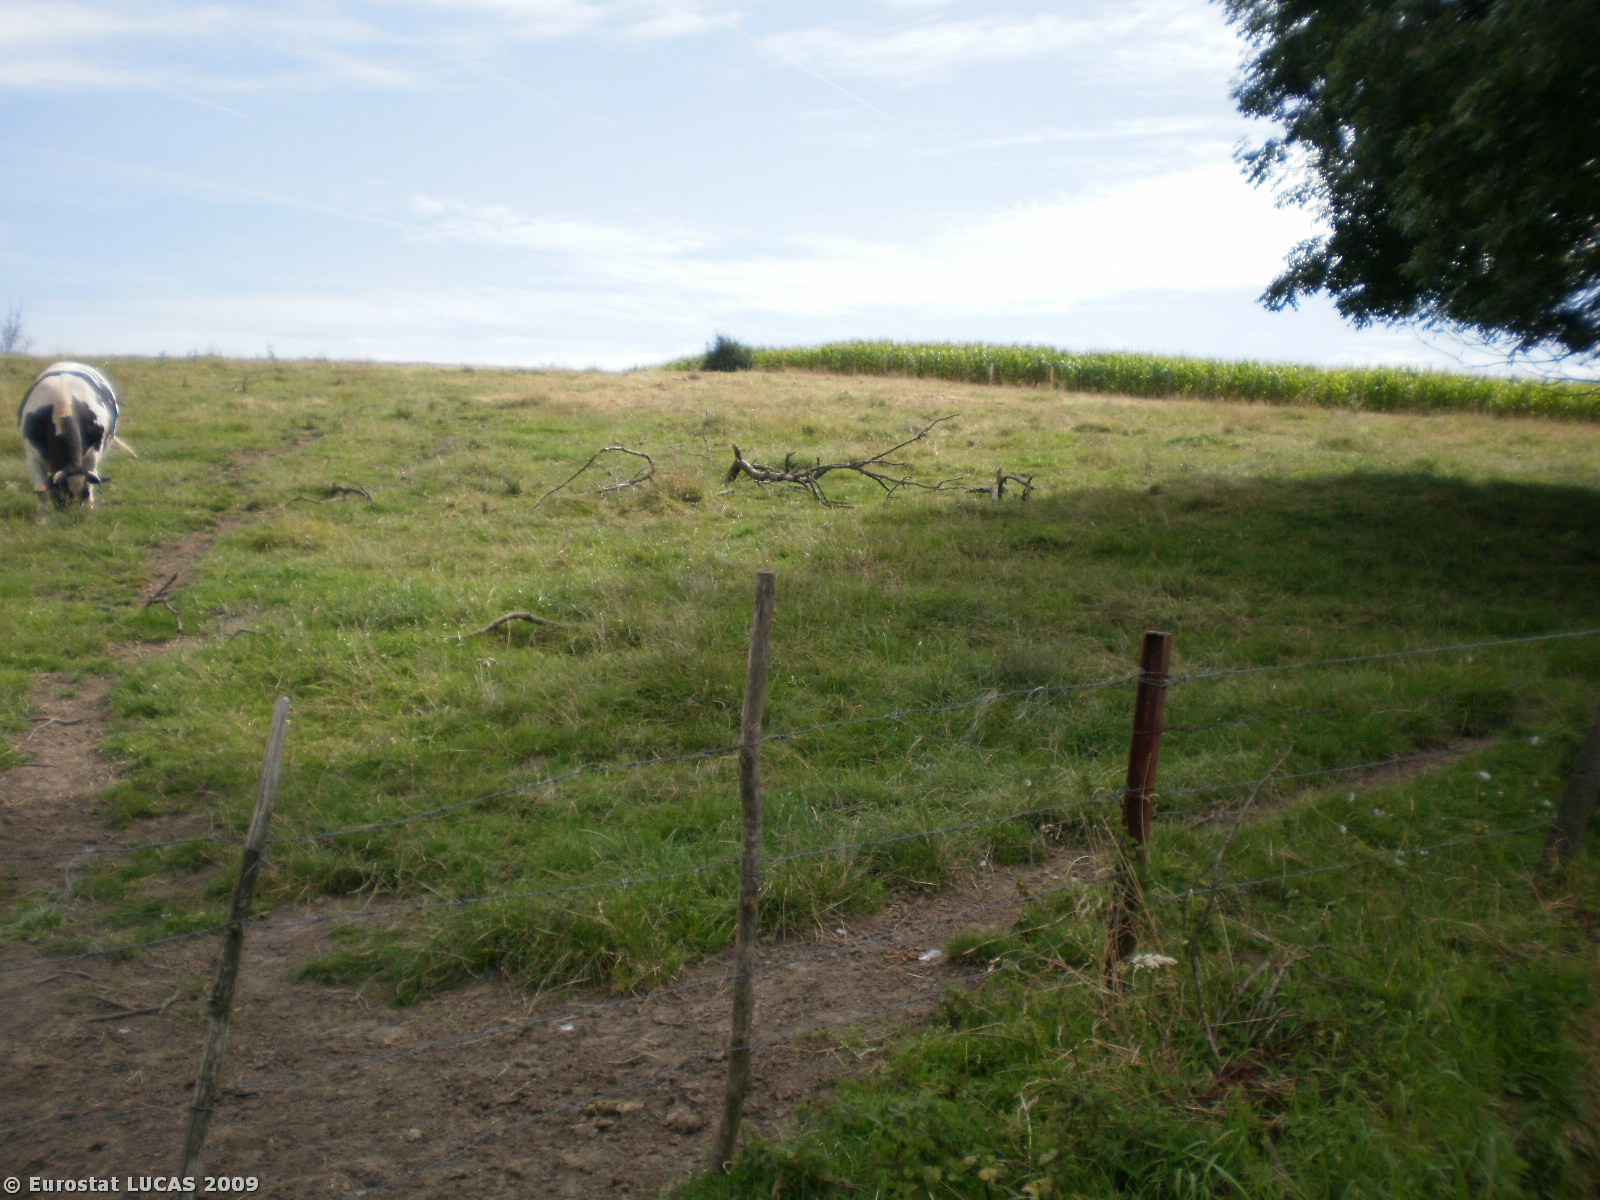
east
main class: Grassland
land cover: Grassland without tree/shrub cover
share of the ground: > 75 %
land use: Agriculture (excluding fallow land and kitchen gardens)
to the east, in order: Grassland without tree/shrub cover; Fences; Single bushes/trees; Common wheat
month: August
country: BE
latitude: 50.7354
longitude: 3.7731
